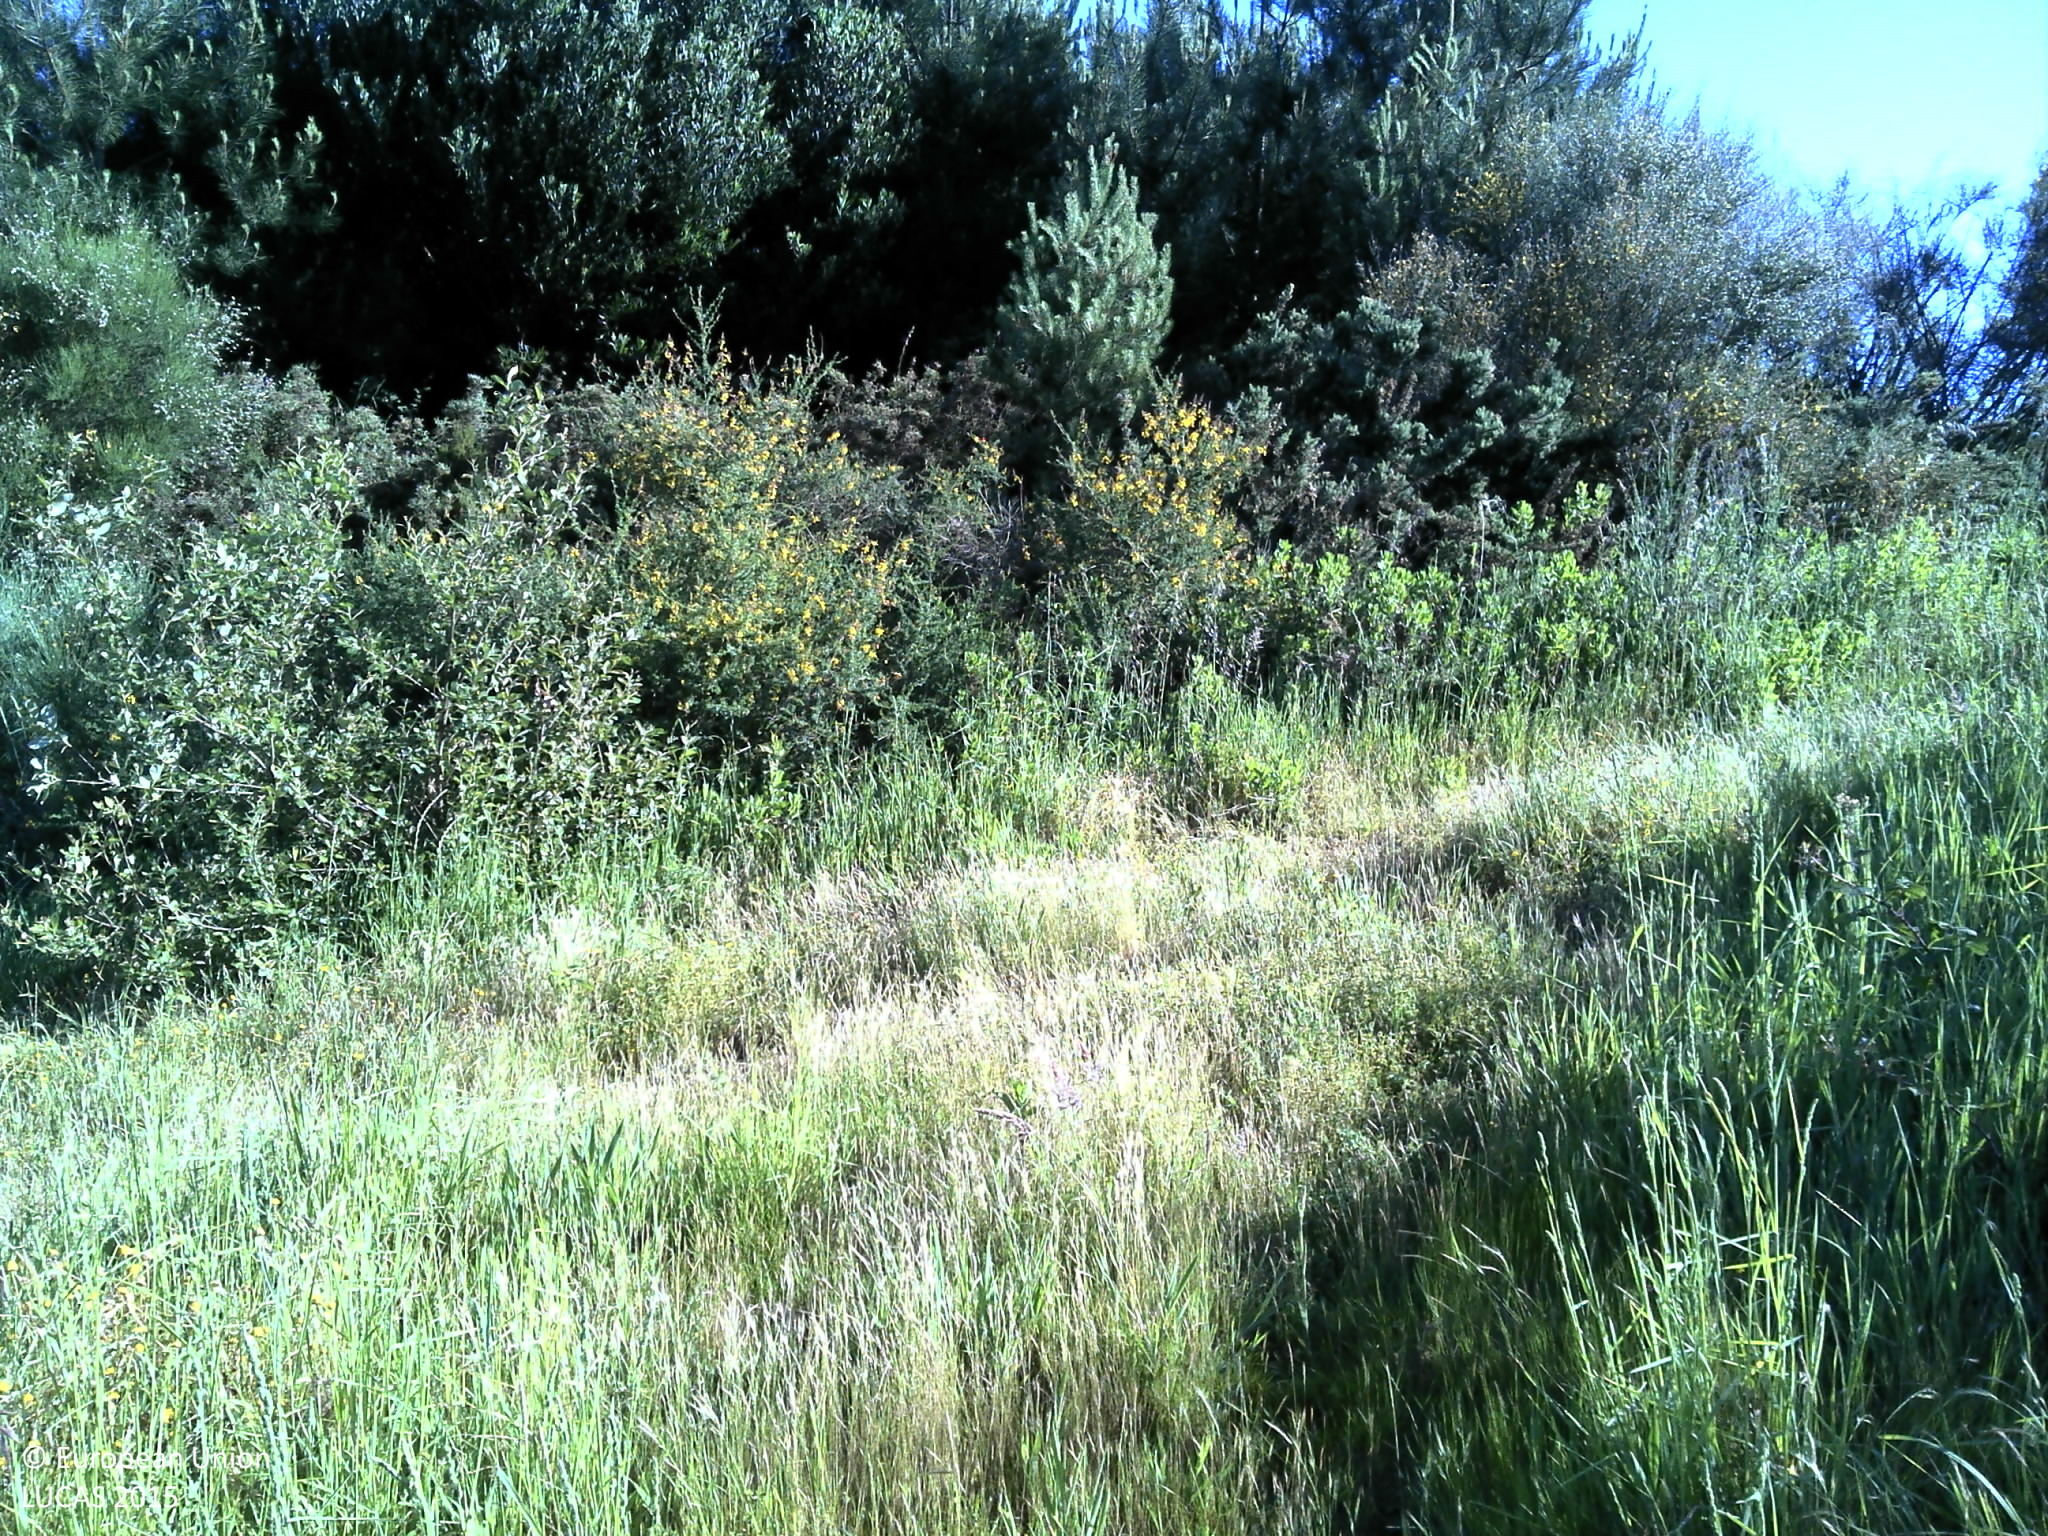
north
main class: Shrubland
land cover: Shrubland without tree cover
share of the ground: 50 - 75 %
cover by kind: shrubs 70 %, herbaceous plants 25 %, unconsolidated bare surface 5 %
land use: Abandoned areas
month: May
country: PT
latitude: 41.2914
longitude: -8.5548
